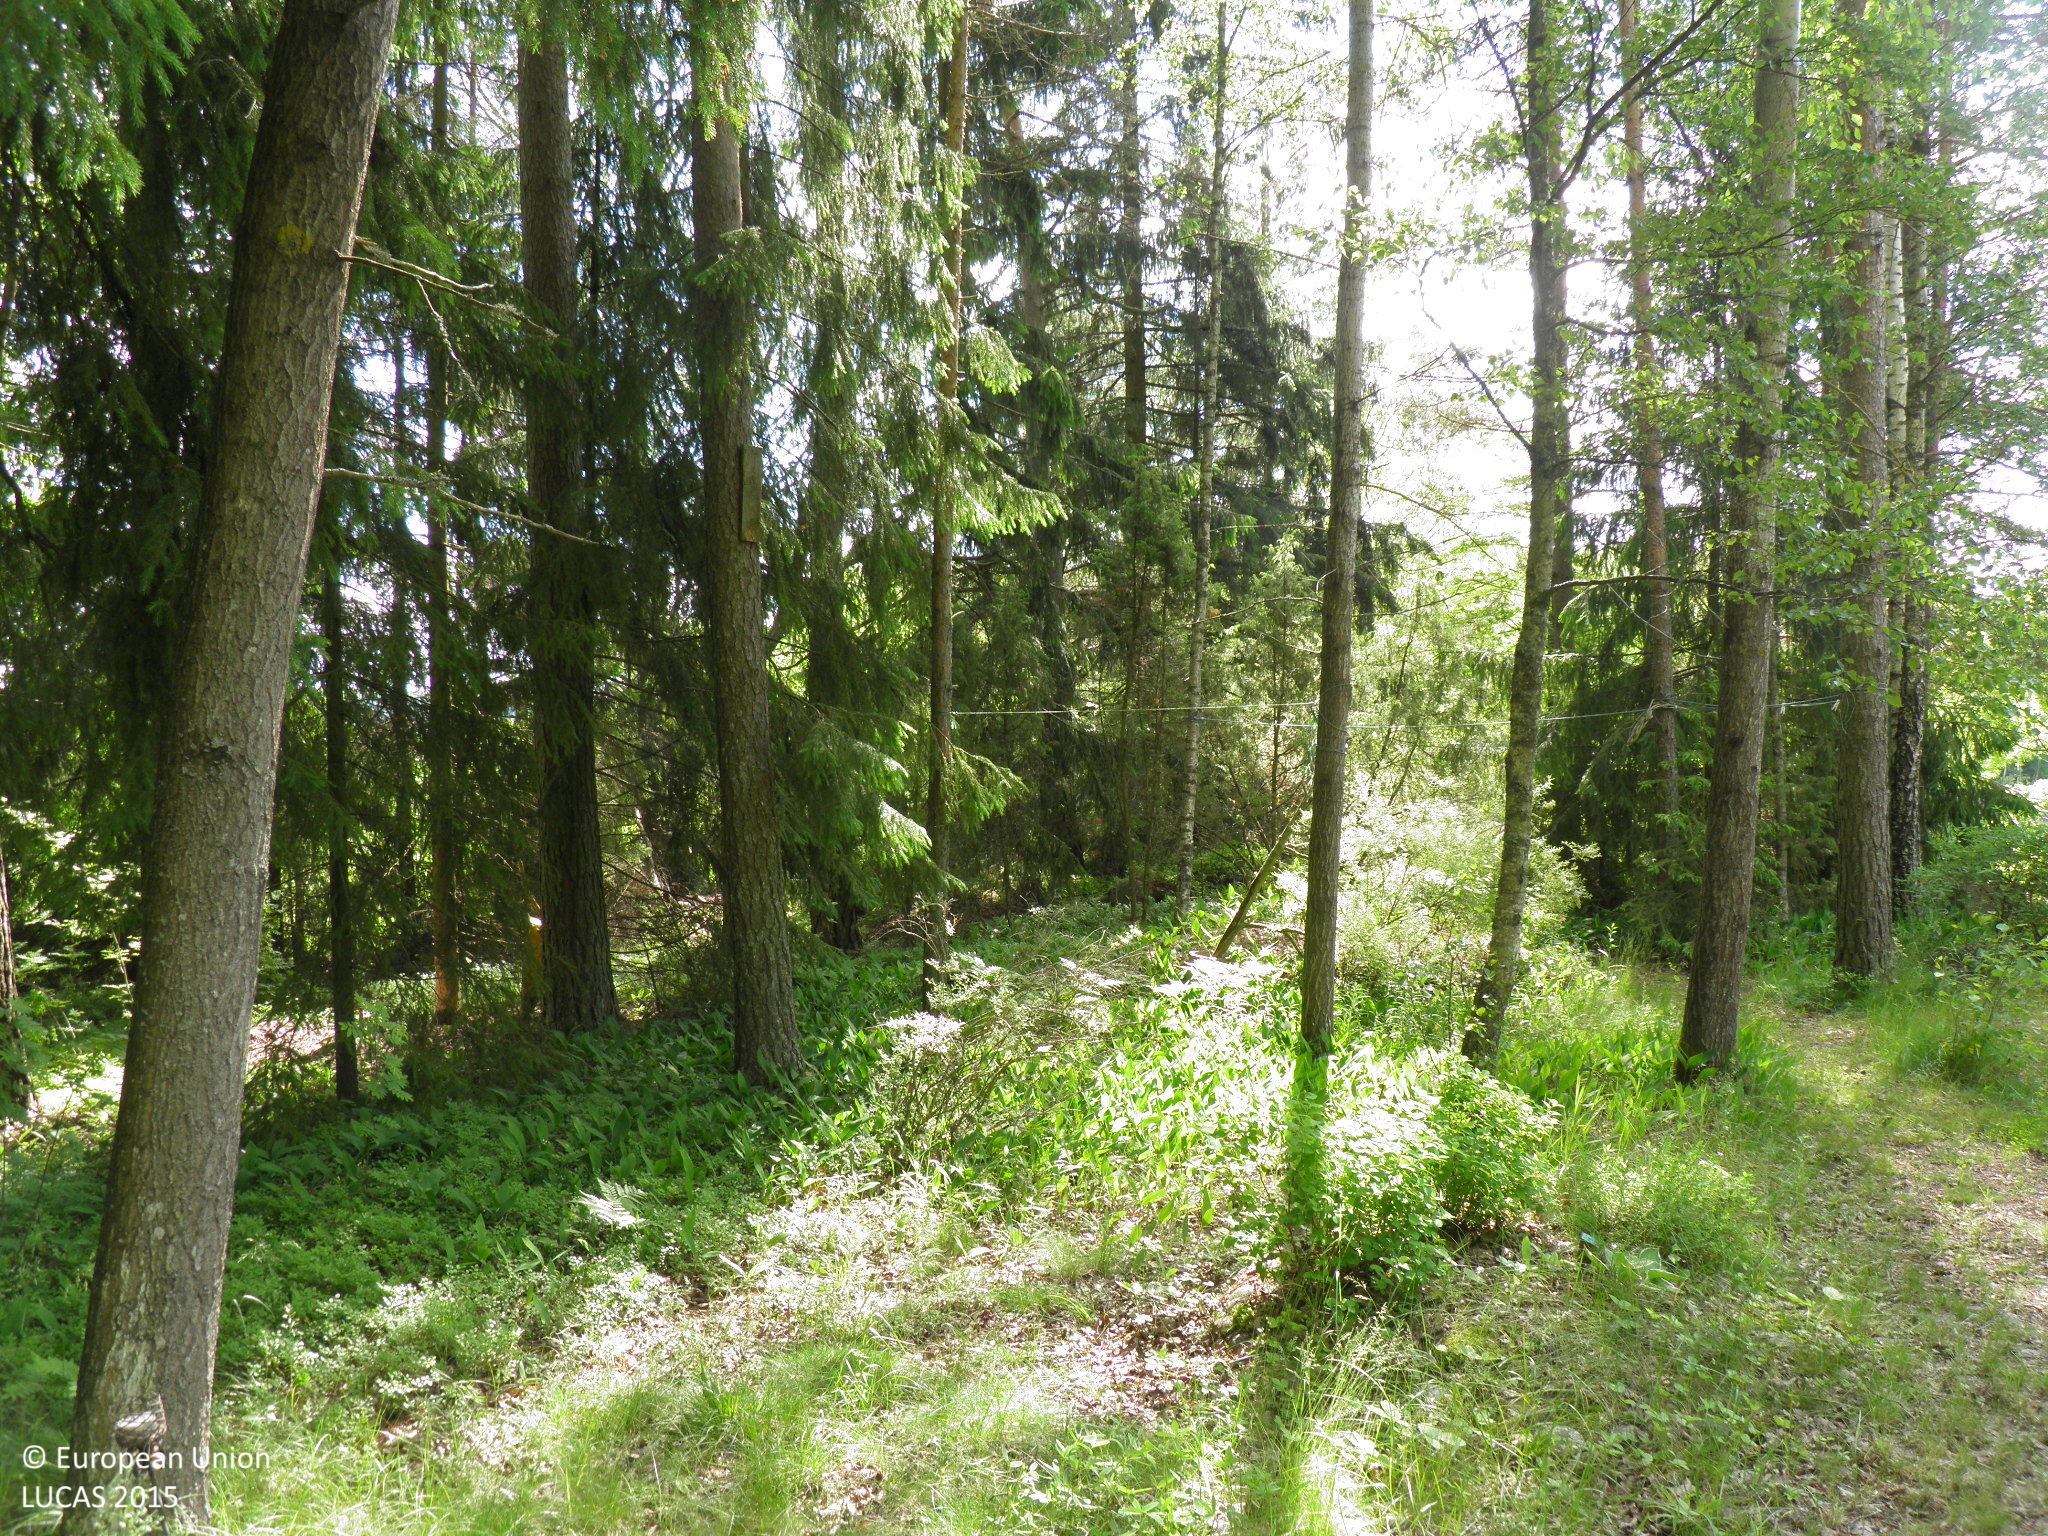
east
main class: Grassland
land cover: Grassland without tree/shrub cover
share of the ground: > 75 %
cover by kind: herbaceous plants 95 %, shrubs 5 %
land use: Residential
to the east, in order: Grassland without tree/shrub cover; Spruce dominated coniferous woodland; Grassland with sparse tree/shrub cover; Fences; Common wheat
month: June
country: FI
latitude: 60.3233
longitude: 22.6214
